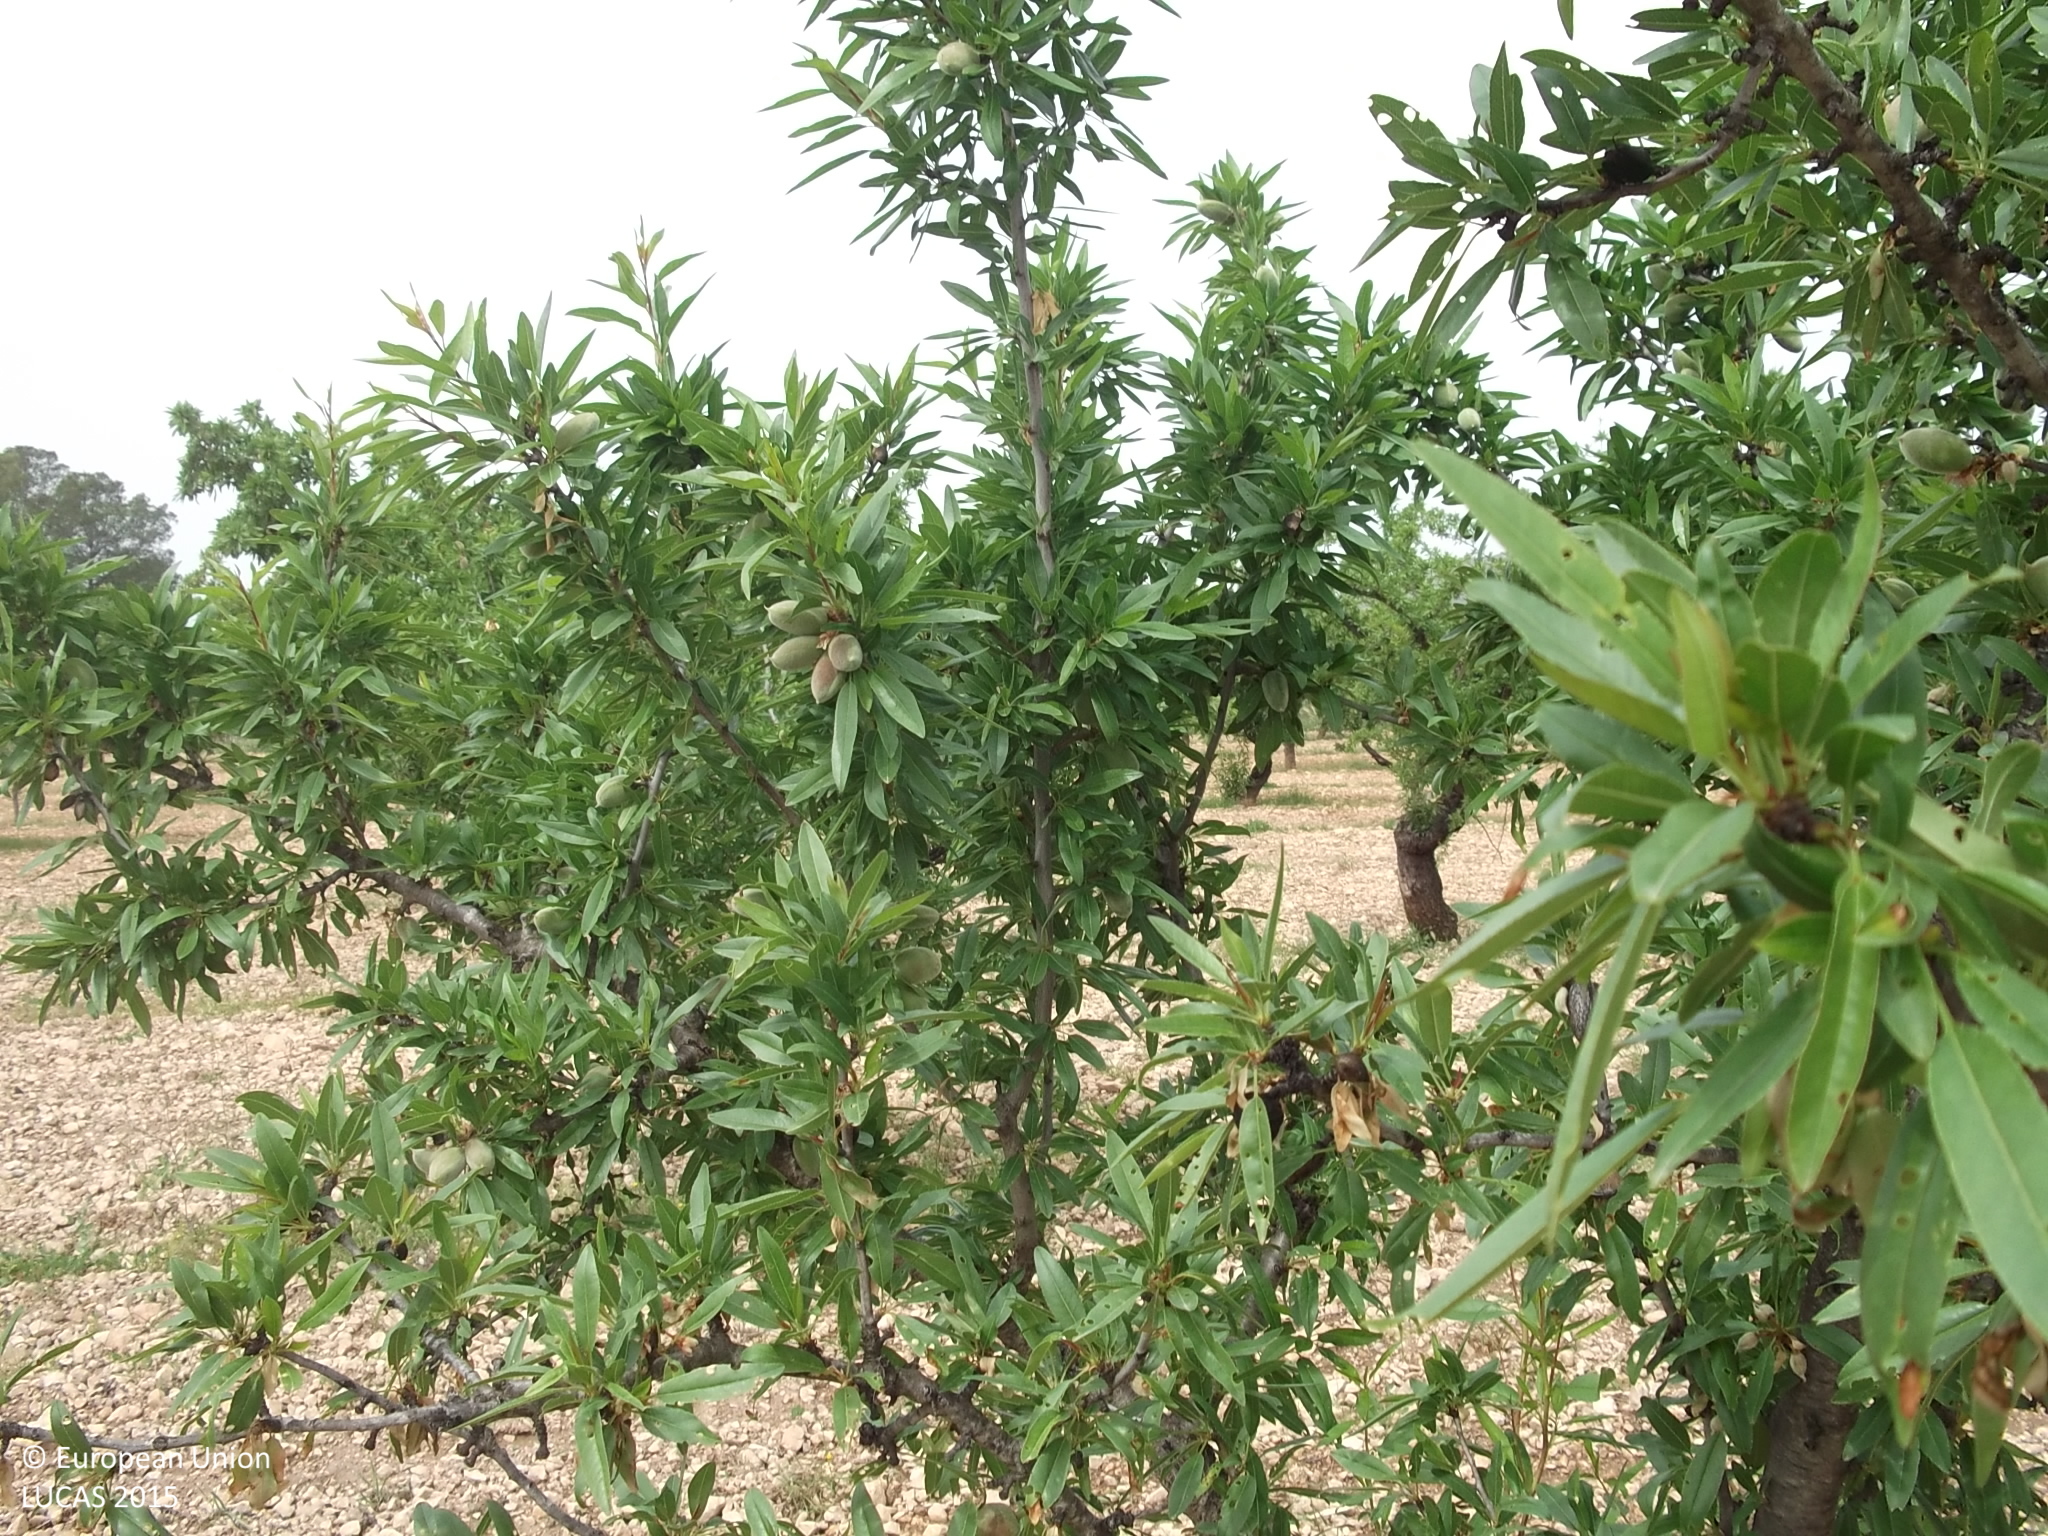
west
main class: Cropland
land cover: Nuts trees
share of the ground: 10 - 25 %
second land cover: Other bare soil
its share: > 75 %
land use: Agriculture (excluding fallow land and kitchen gardens)
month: April
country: ES
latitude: 38.2746
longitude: -1.6380
